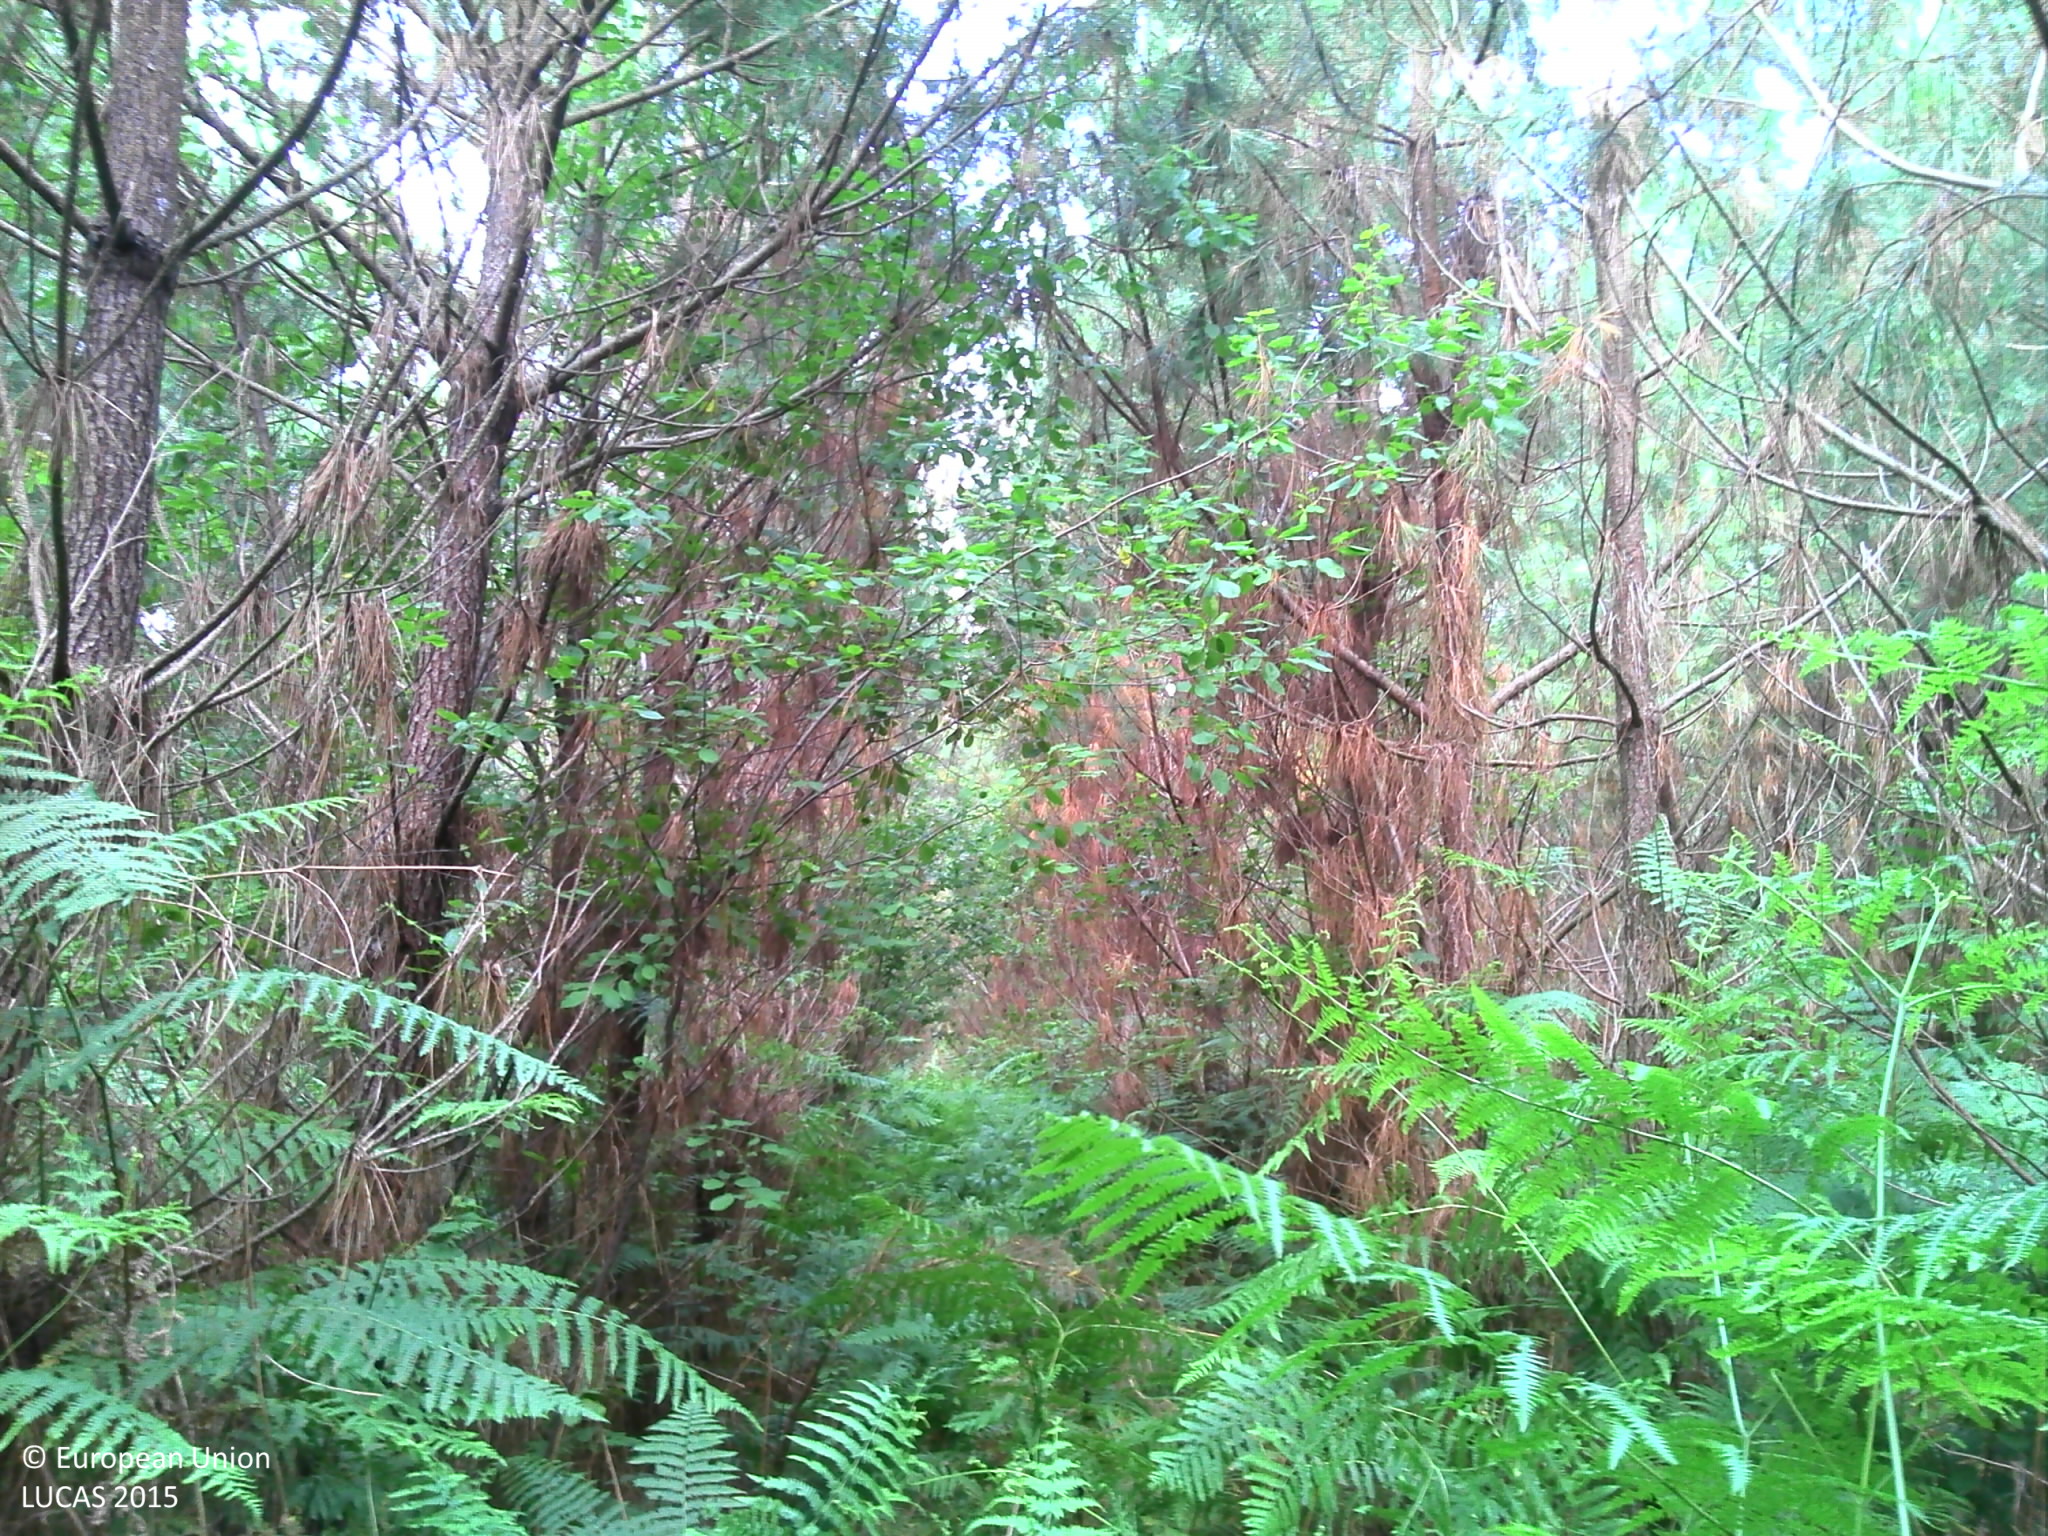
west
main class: Woodland
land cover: Pine dominated coniferous woodland
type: coniferous forest of the mediterranean region
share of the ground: > 75 %
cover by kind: coniferous forest trees 80 %, herbaceous plants 10 %, broadleaved forest trees 5 %, shrubs 5 %
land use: Forestry
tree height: > 5 m
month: July
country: FR
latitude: 43.6391
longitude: -1.3105
